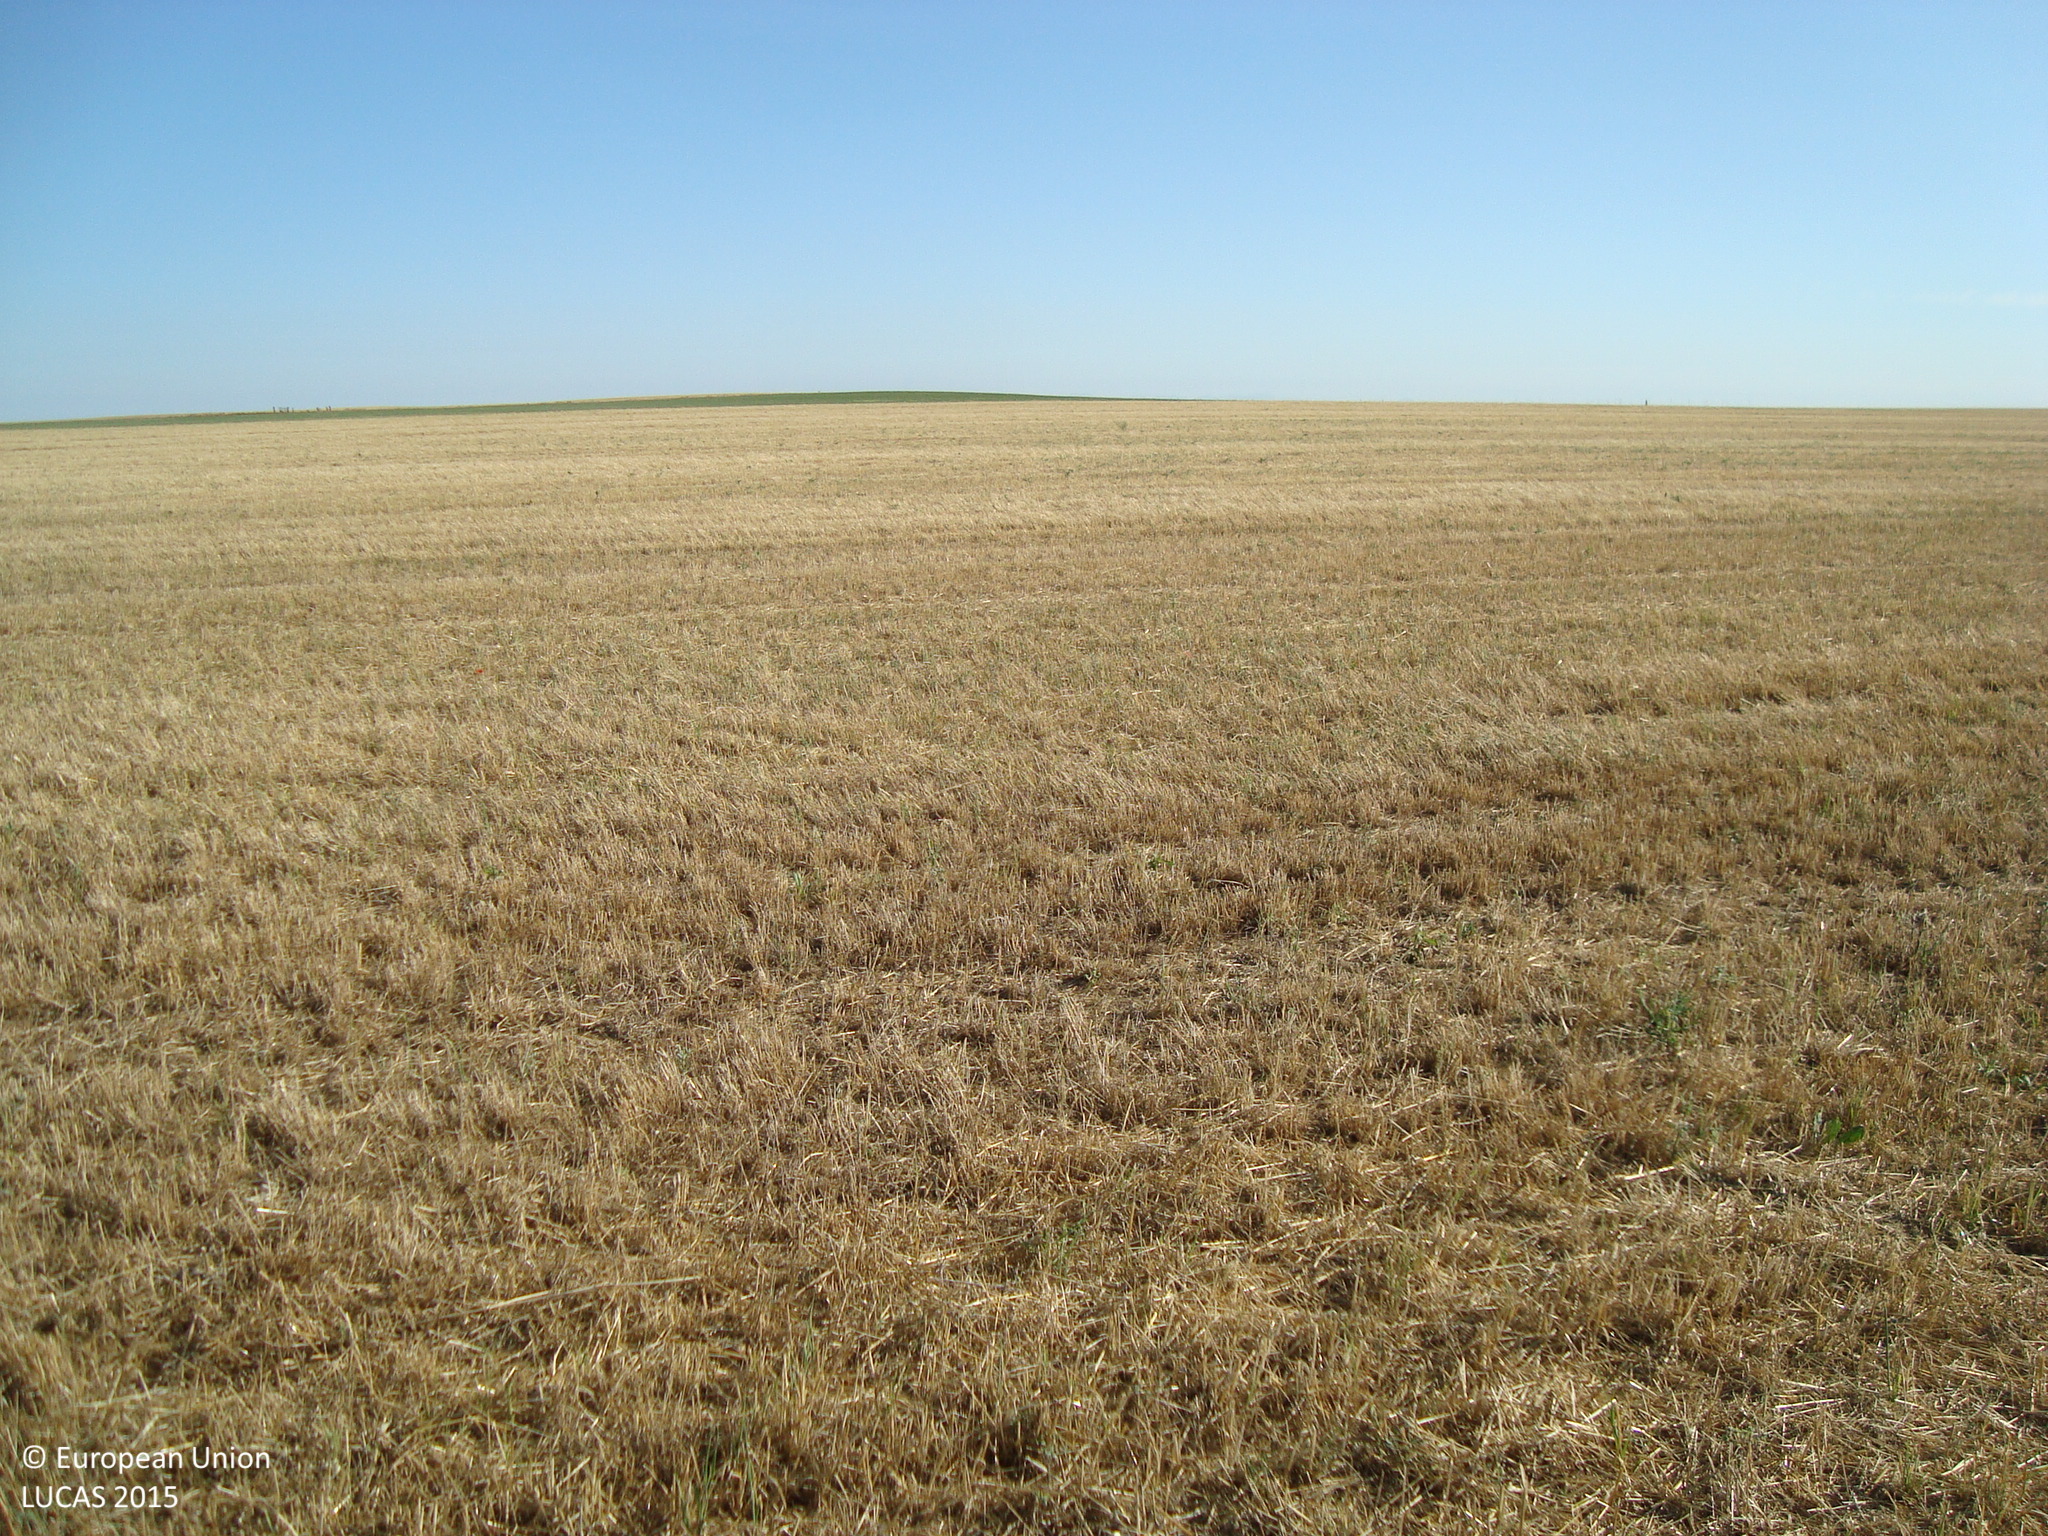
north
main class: Cropland
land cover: Barley
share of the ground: < 10 %
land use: Agriculture (excluding fallow land and kitchen gardens)
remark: Harvested field
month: July
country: ES
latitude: 42.0364
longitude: -4.8004
